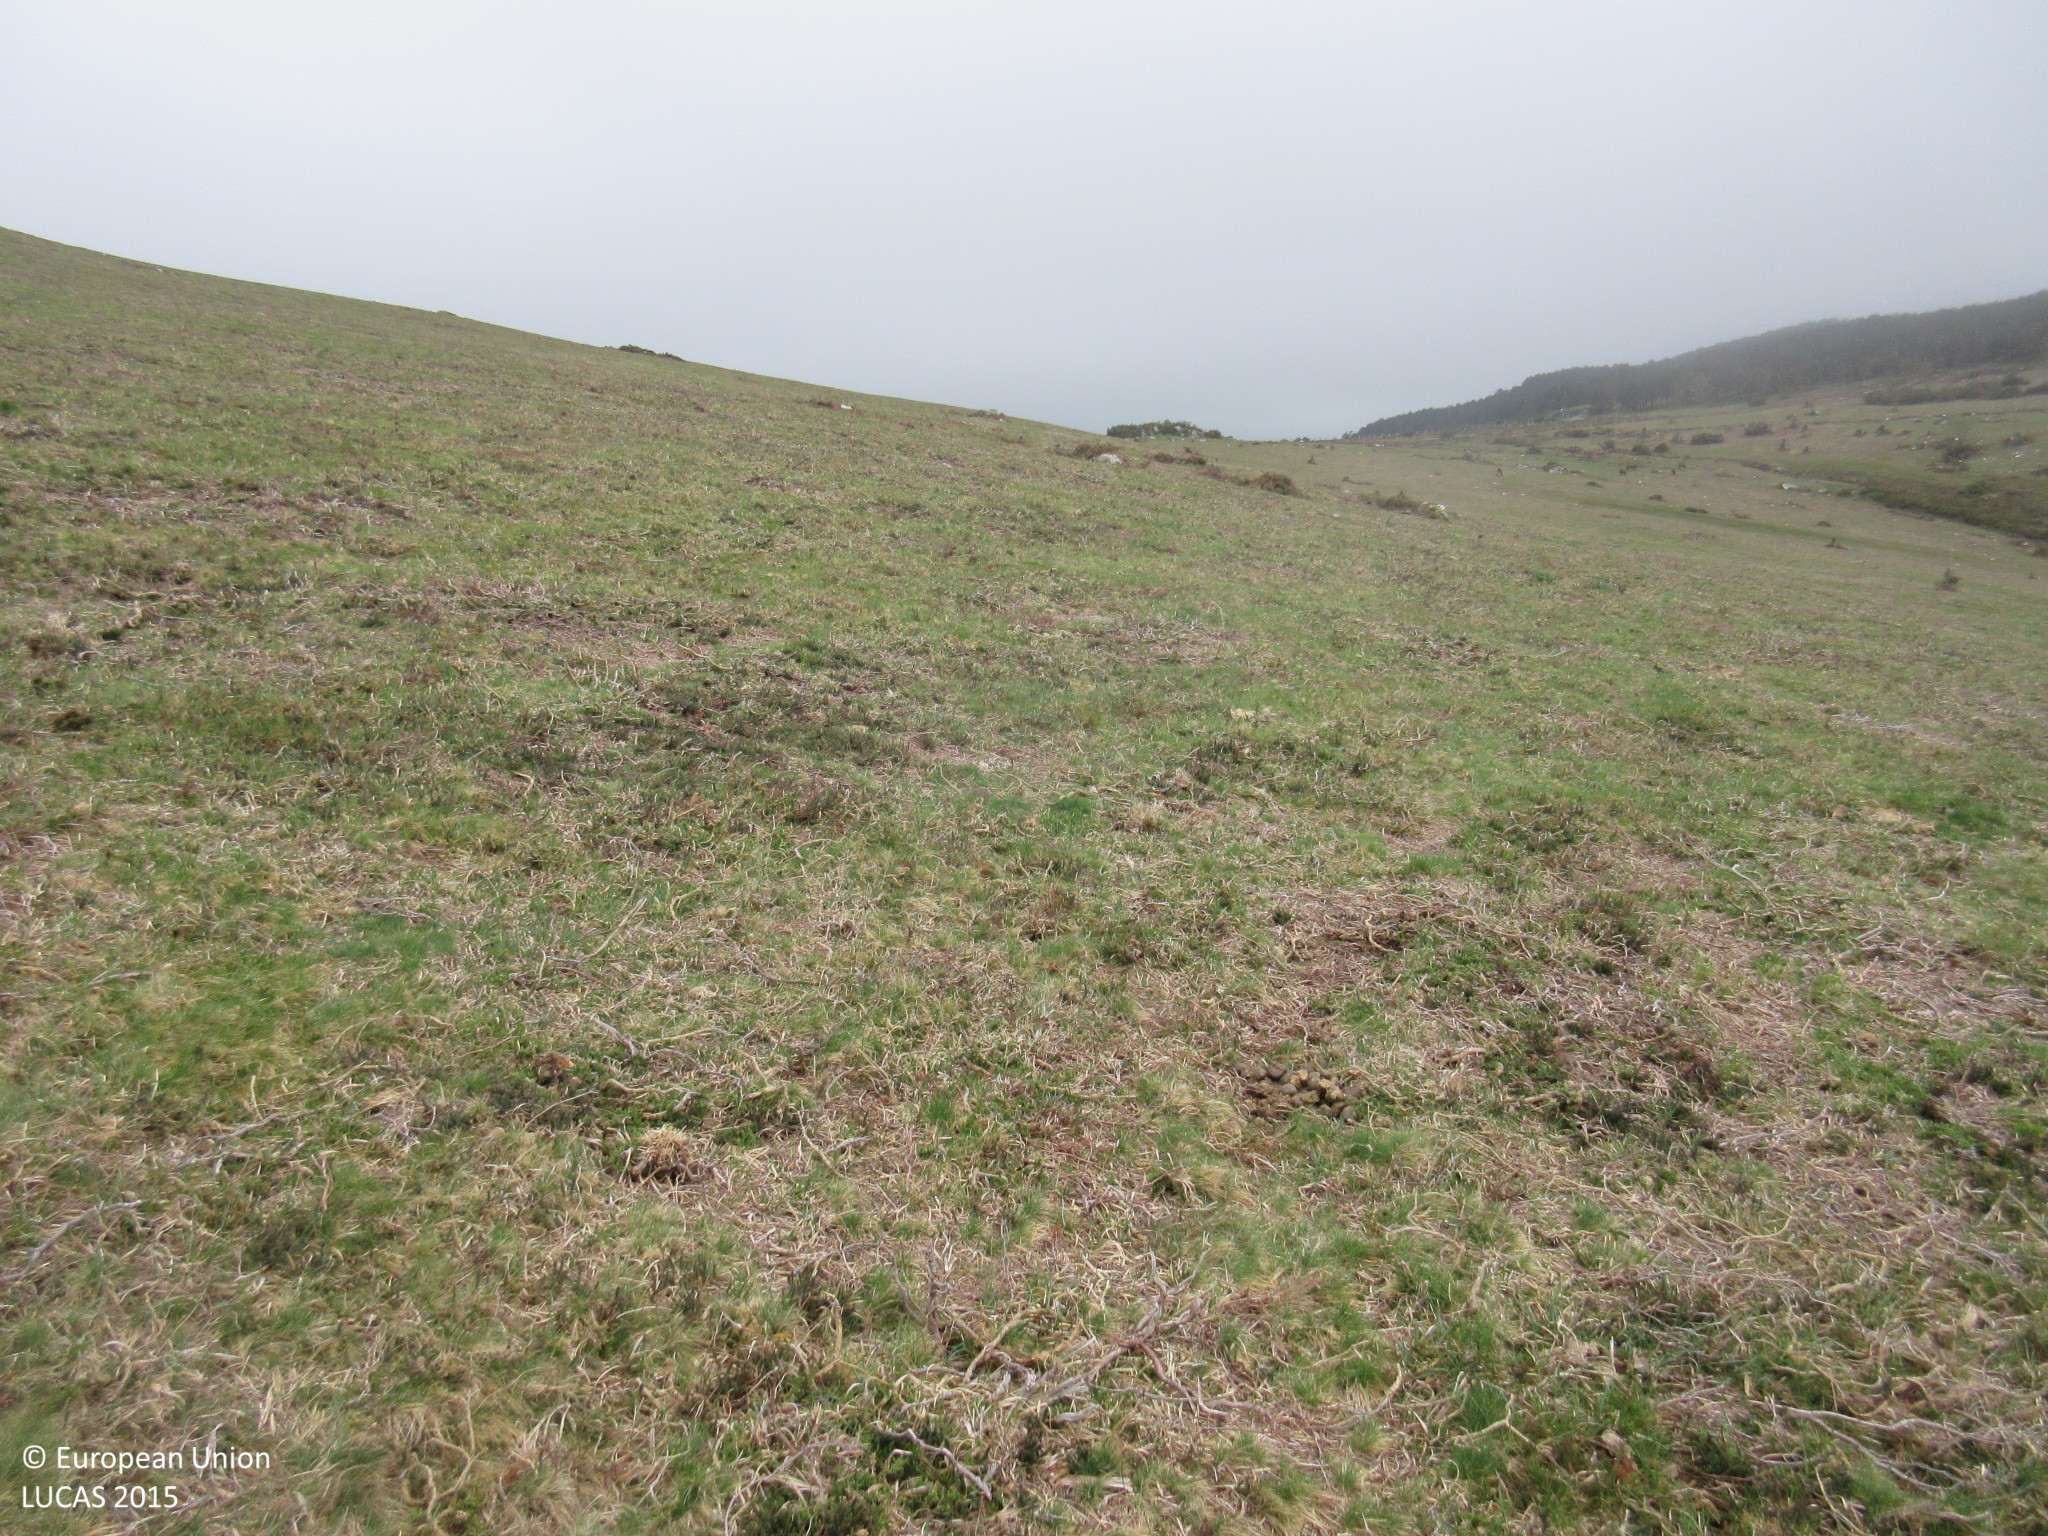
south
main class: Grassland
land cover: Grassland without tree/shrub cover
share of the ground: > 75 %
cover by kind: herbaceous plants 100 %
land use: Agriculture (excluding fallow land and kitchen gardens)
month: April
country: ES
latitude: 43.3613
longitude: -6.9831
